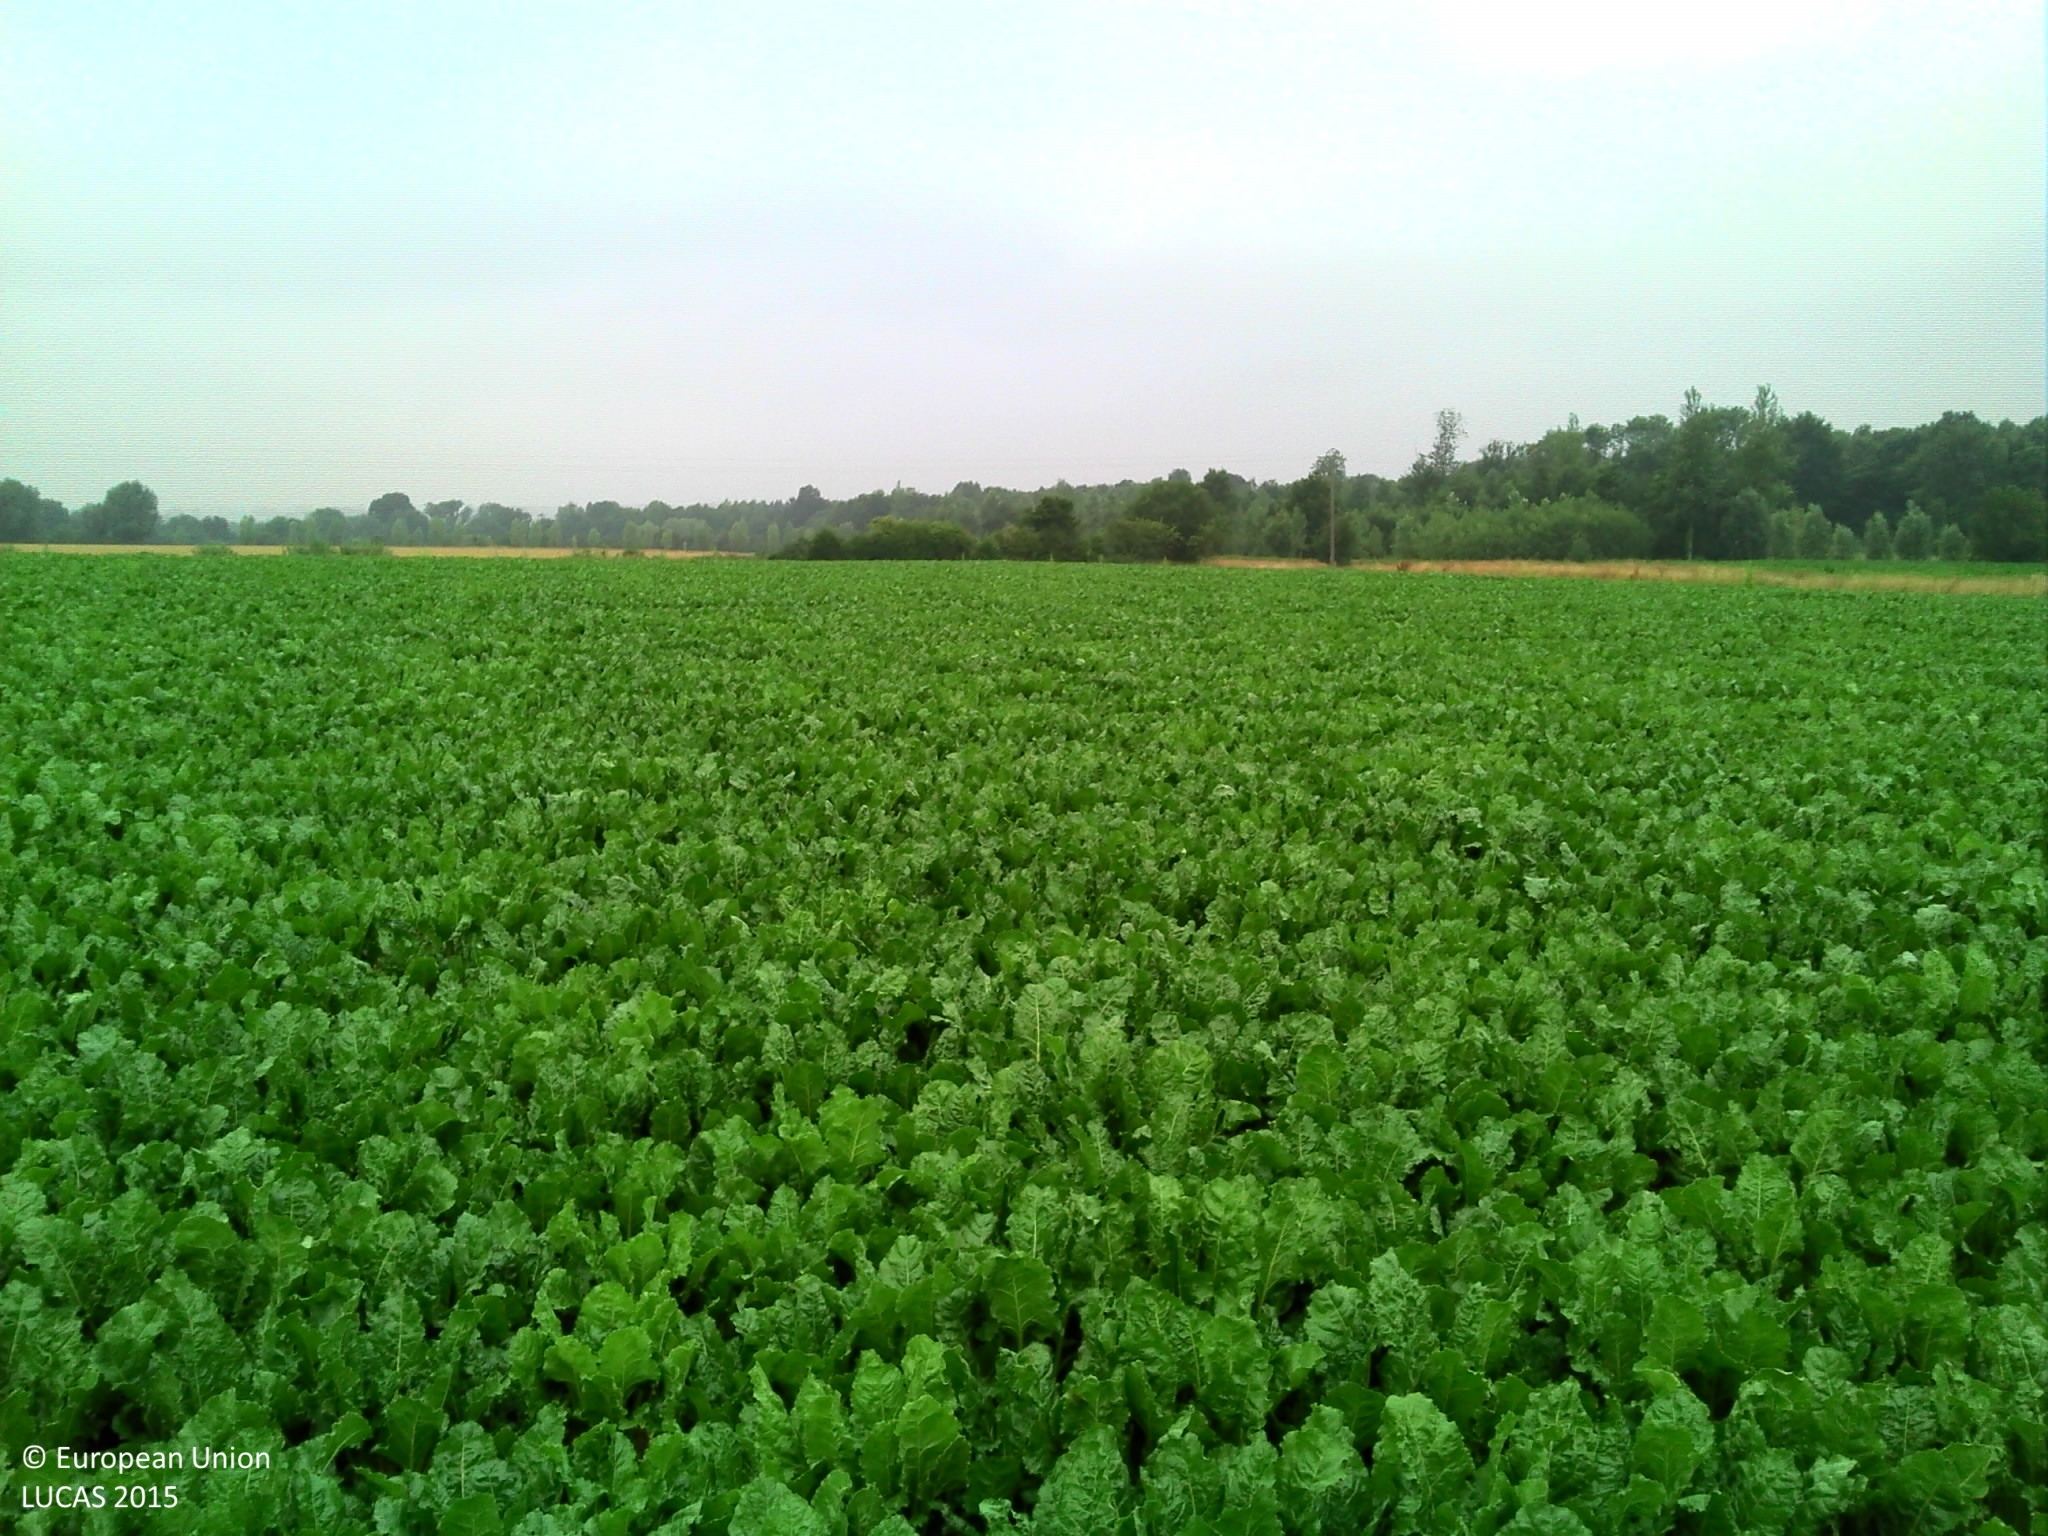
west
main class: Cropland
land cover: Sugar beet
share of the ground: > 75 %
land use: Agriculture (excluding fallow land and kitchen gardens)
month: July
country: BE
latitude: 50.3534
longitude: 4.0493
